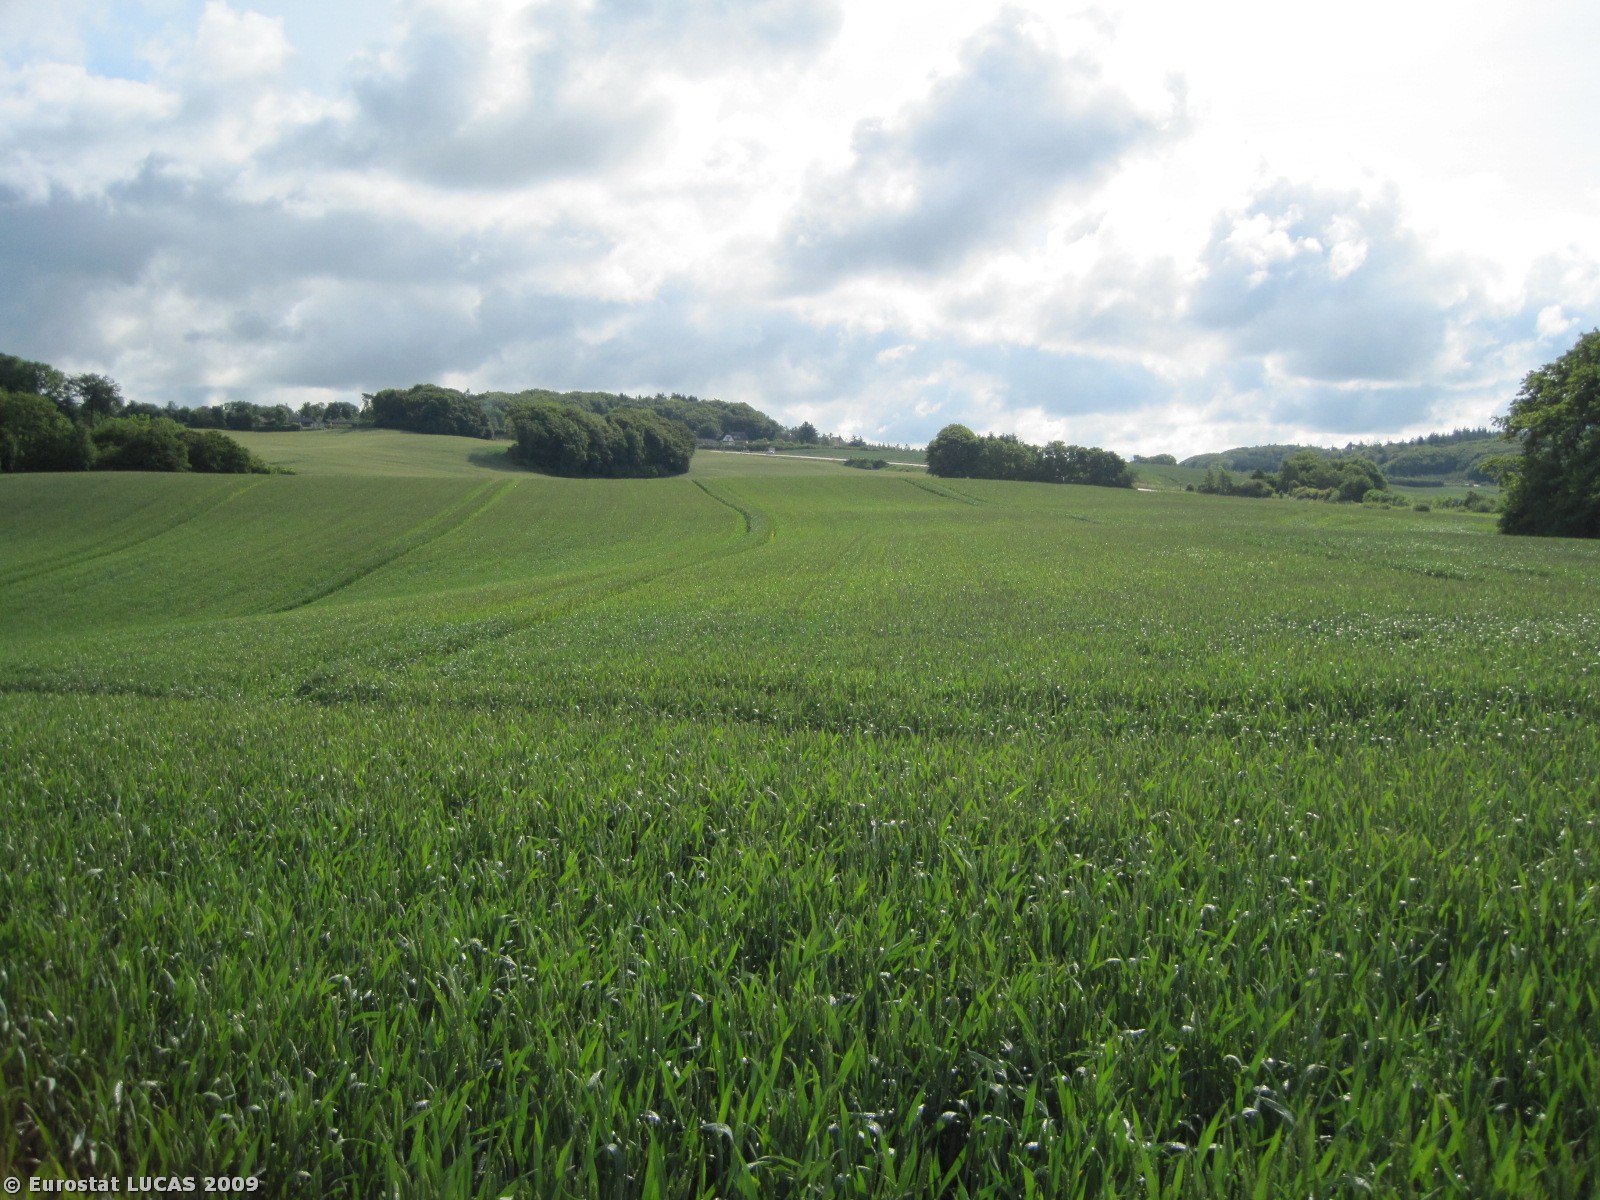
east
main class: Grassland
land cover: Grassland without tree/shrub cover
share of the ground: > 75 %
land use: Agriculture (excluding fallow land and kitchen gardens)
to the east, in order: Grassland without tree/shrub cover; Fences; Grassland without tree/shrub cover; Electric lines; Grassland without tree/shrub cover; Fences; Common wheat
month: June
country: DK
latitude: 57.3023
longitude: 10.1491
